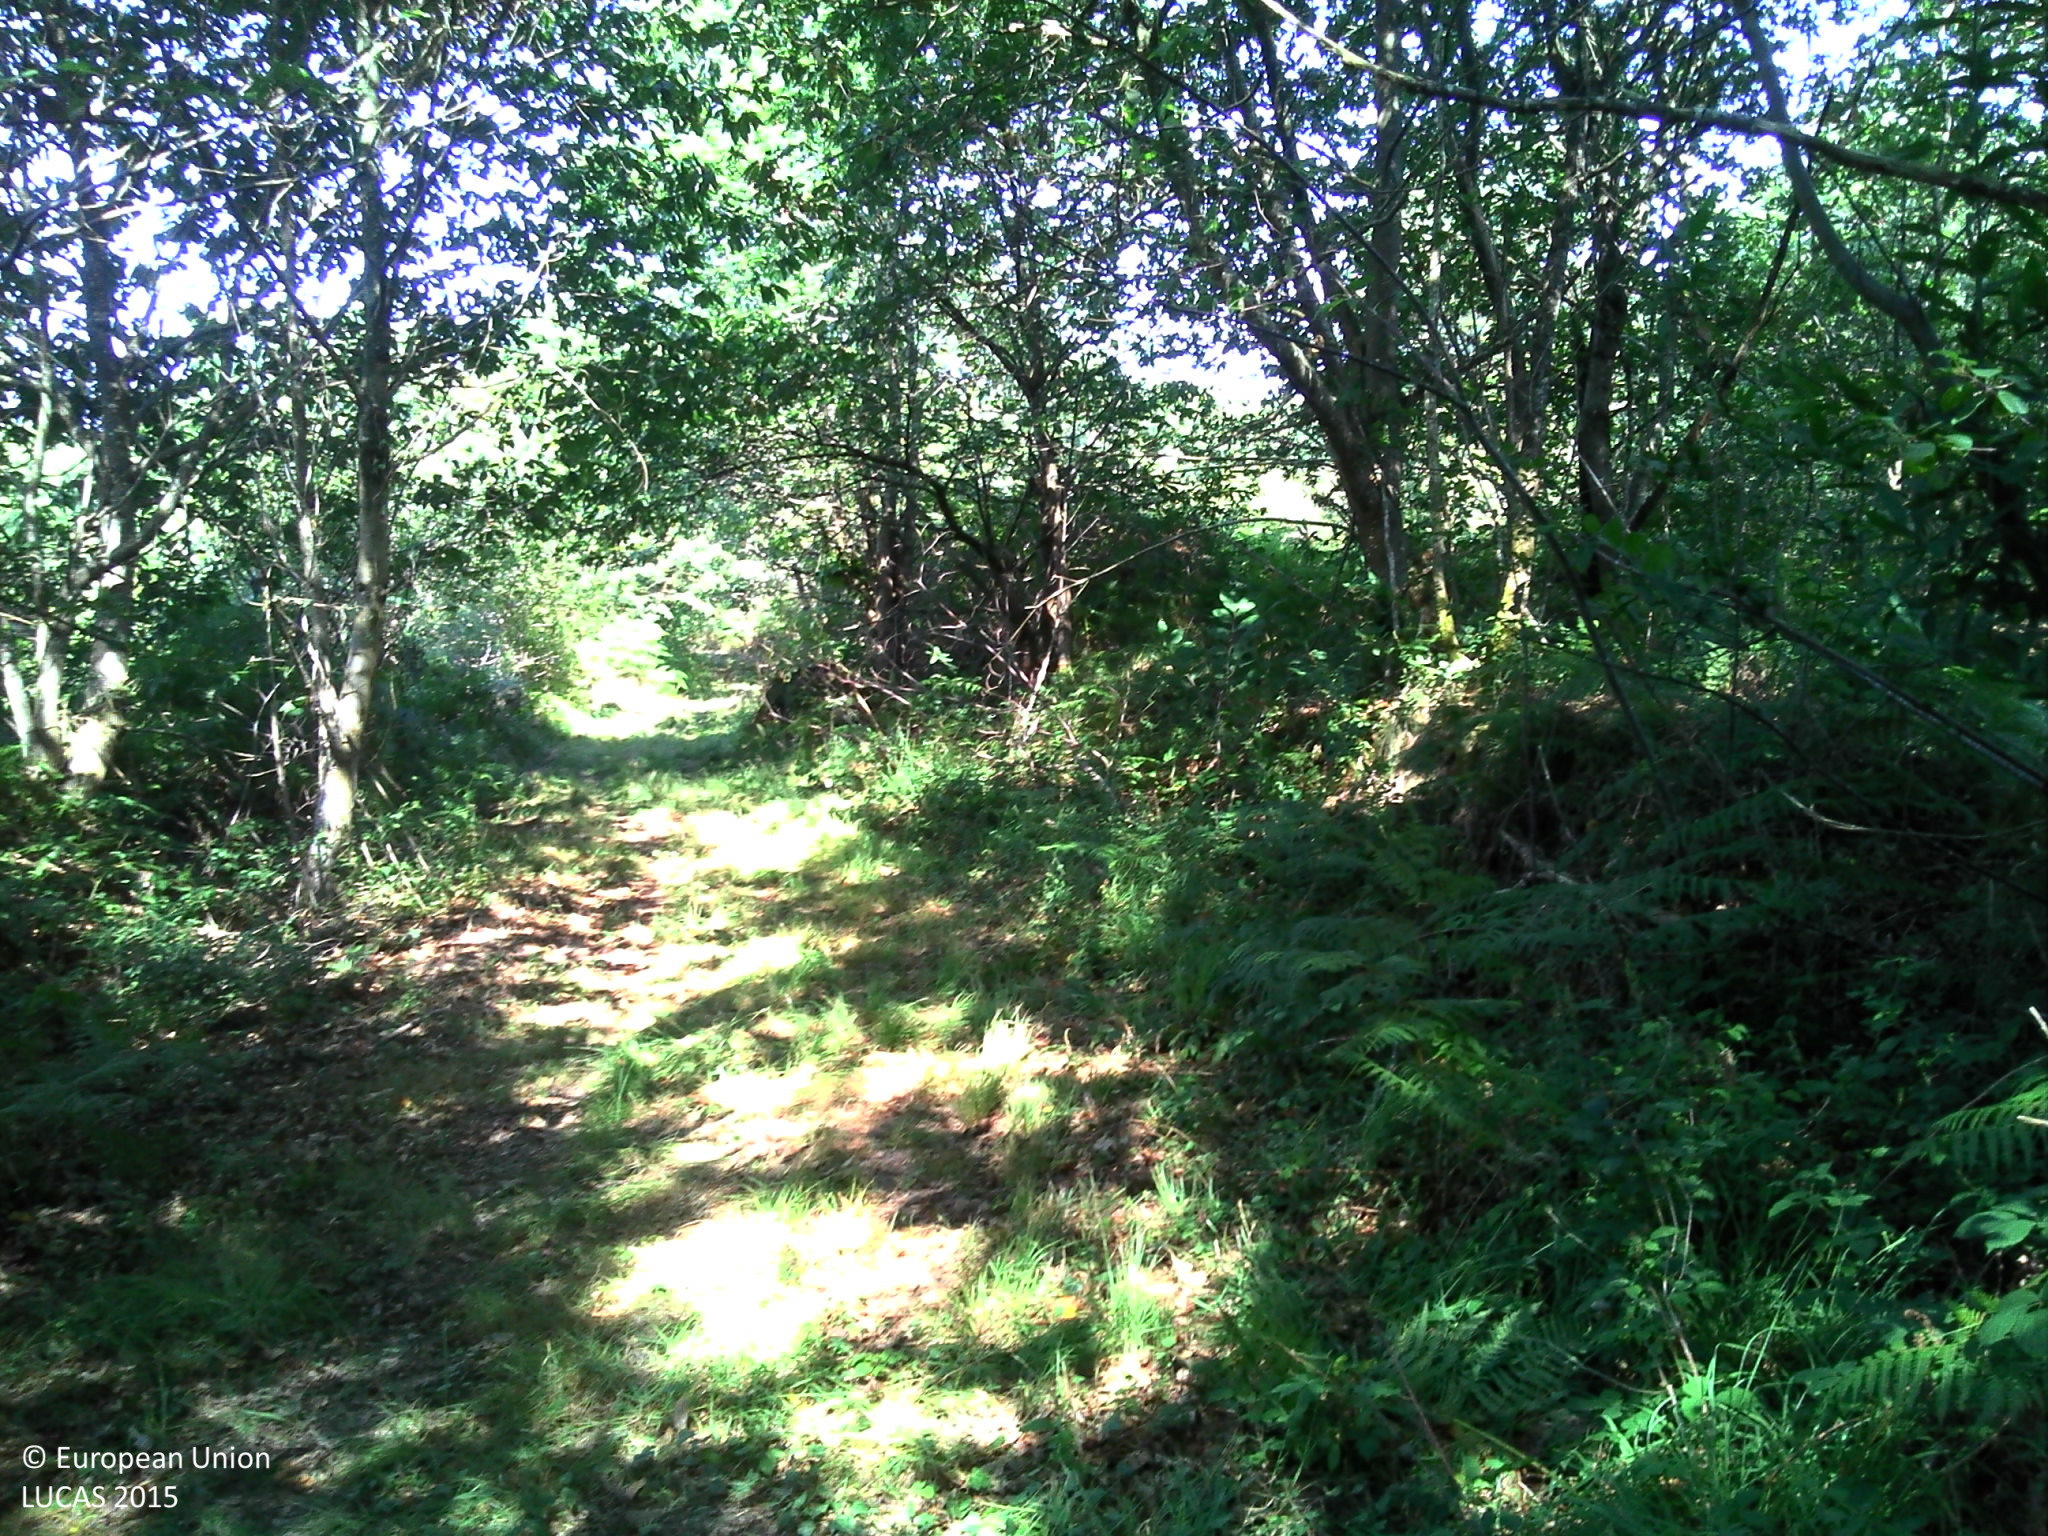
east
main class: Shrubland
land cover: Shrubland with sparse tree cover
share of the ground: > 75 %
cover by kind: shrubs 75 %, herbaceous plants 20 %, broadleaved forest trees 5 %
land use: Forestry
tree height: > 5 m
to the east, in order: Shrubland with sparse tree cover; Broadleaved woodland; Shrubland without tree cover; Common wheat
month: August
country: FR
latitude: 43.7152
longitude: -0.7740
